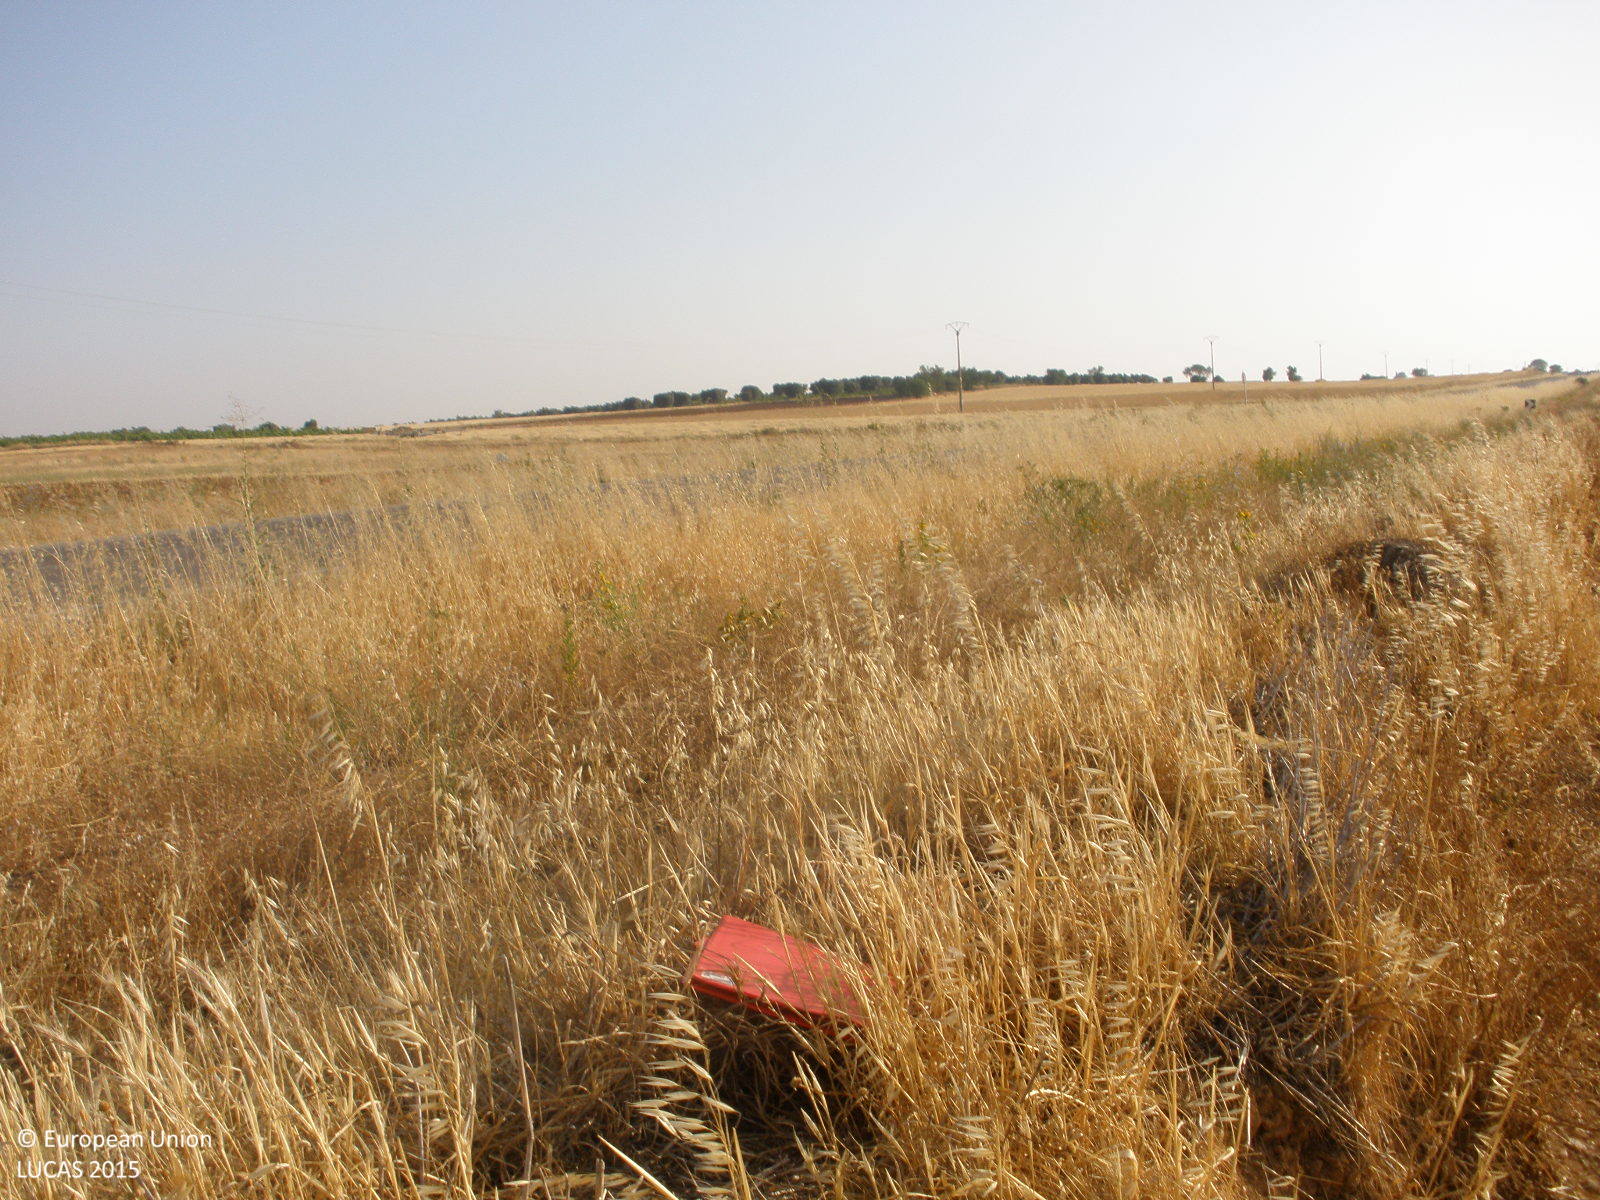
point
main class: Cropland
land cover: Oats
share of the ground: < 10 %
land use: Agriculture (excluding fallow land and kitchen gardens)
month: July
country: ES
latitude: 39.8037
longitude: -3.1155
